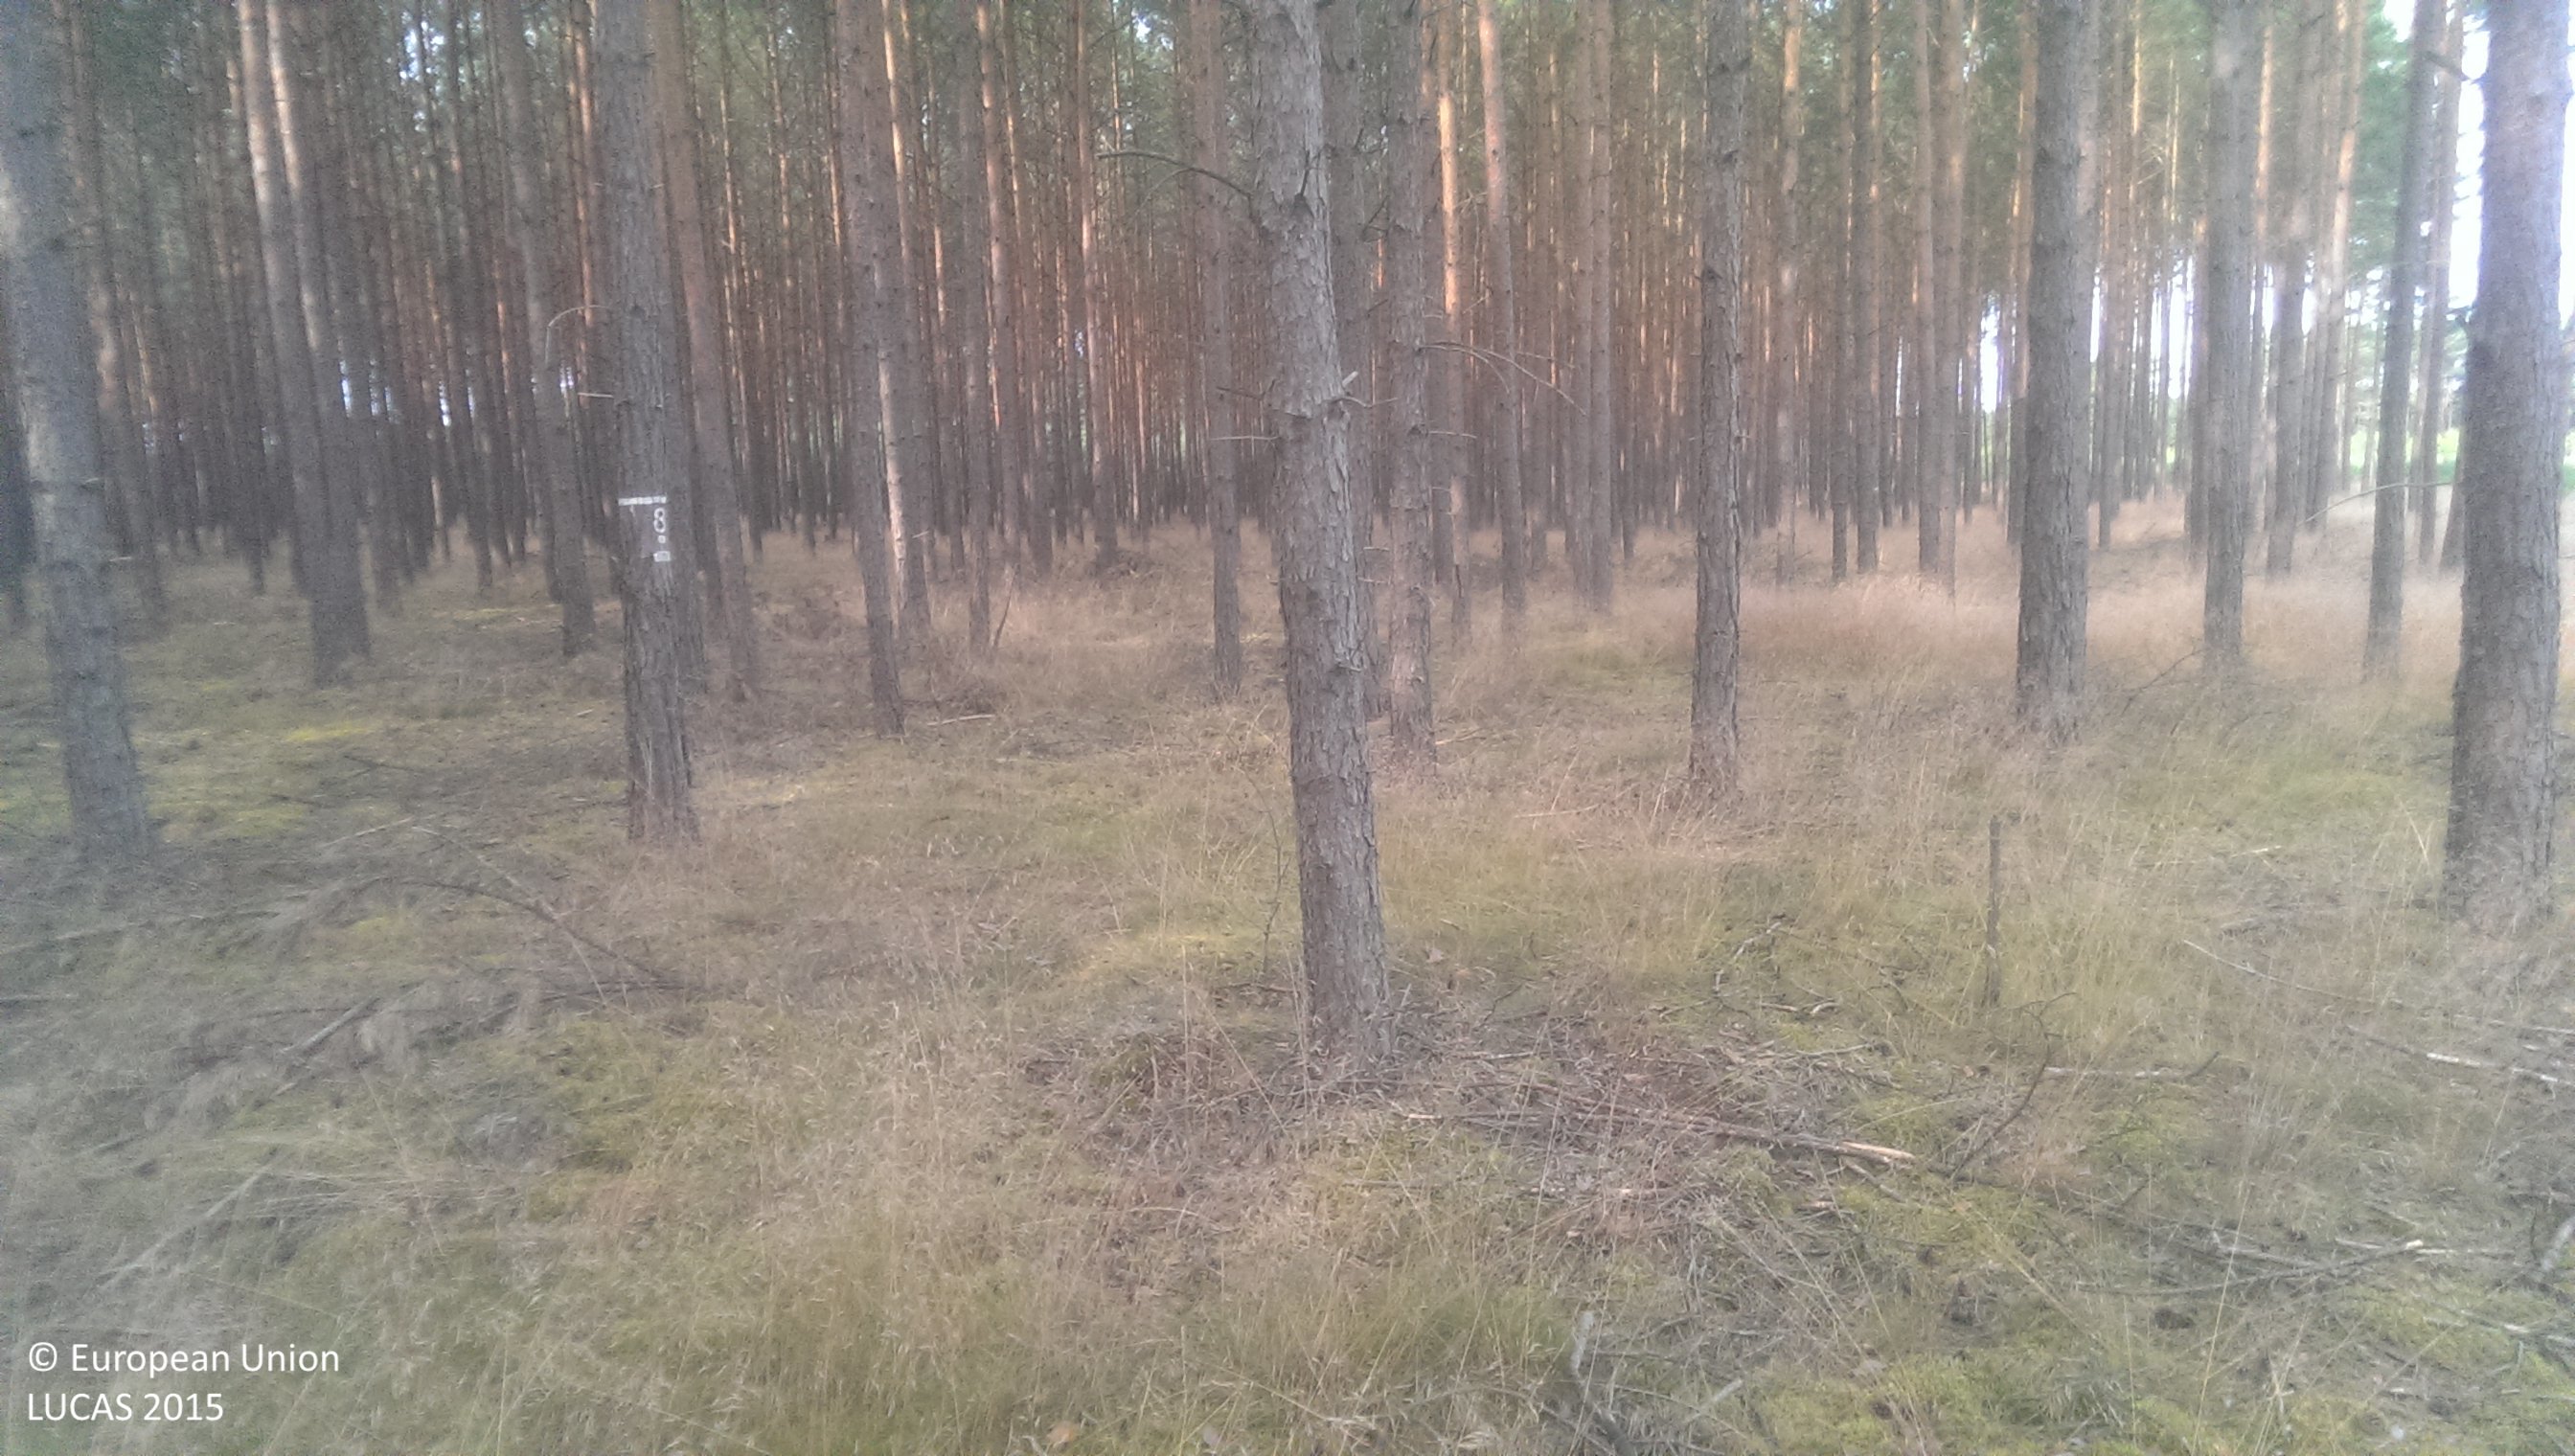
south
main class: Woodland
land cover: Pine dominated coniferous woodland
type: hemiboreal forest and nemoral coniferous forest and mixed broadleaved-coniferous forest
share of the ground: 50 - 75 %
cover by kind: coniferous forest trees 70 %, lichens and mosses 20 %, herbaceous plants 10 %
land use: Forestry
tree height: > 5 m
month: July
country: PL
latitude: 52.3701
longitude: 15.6297
